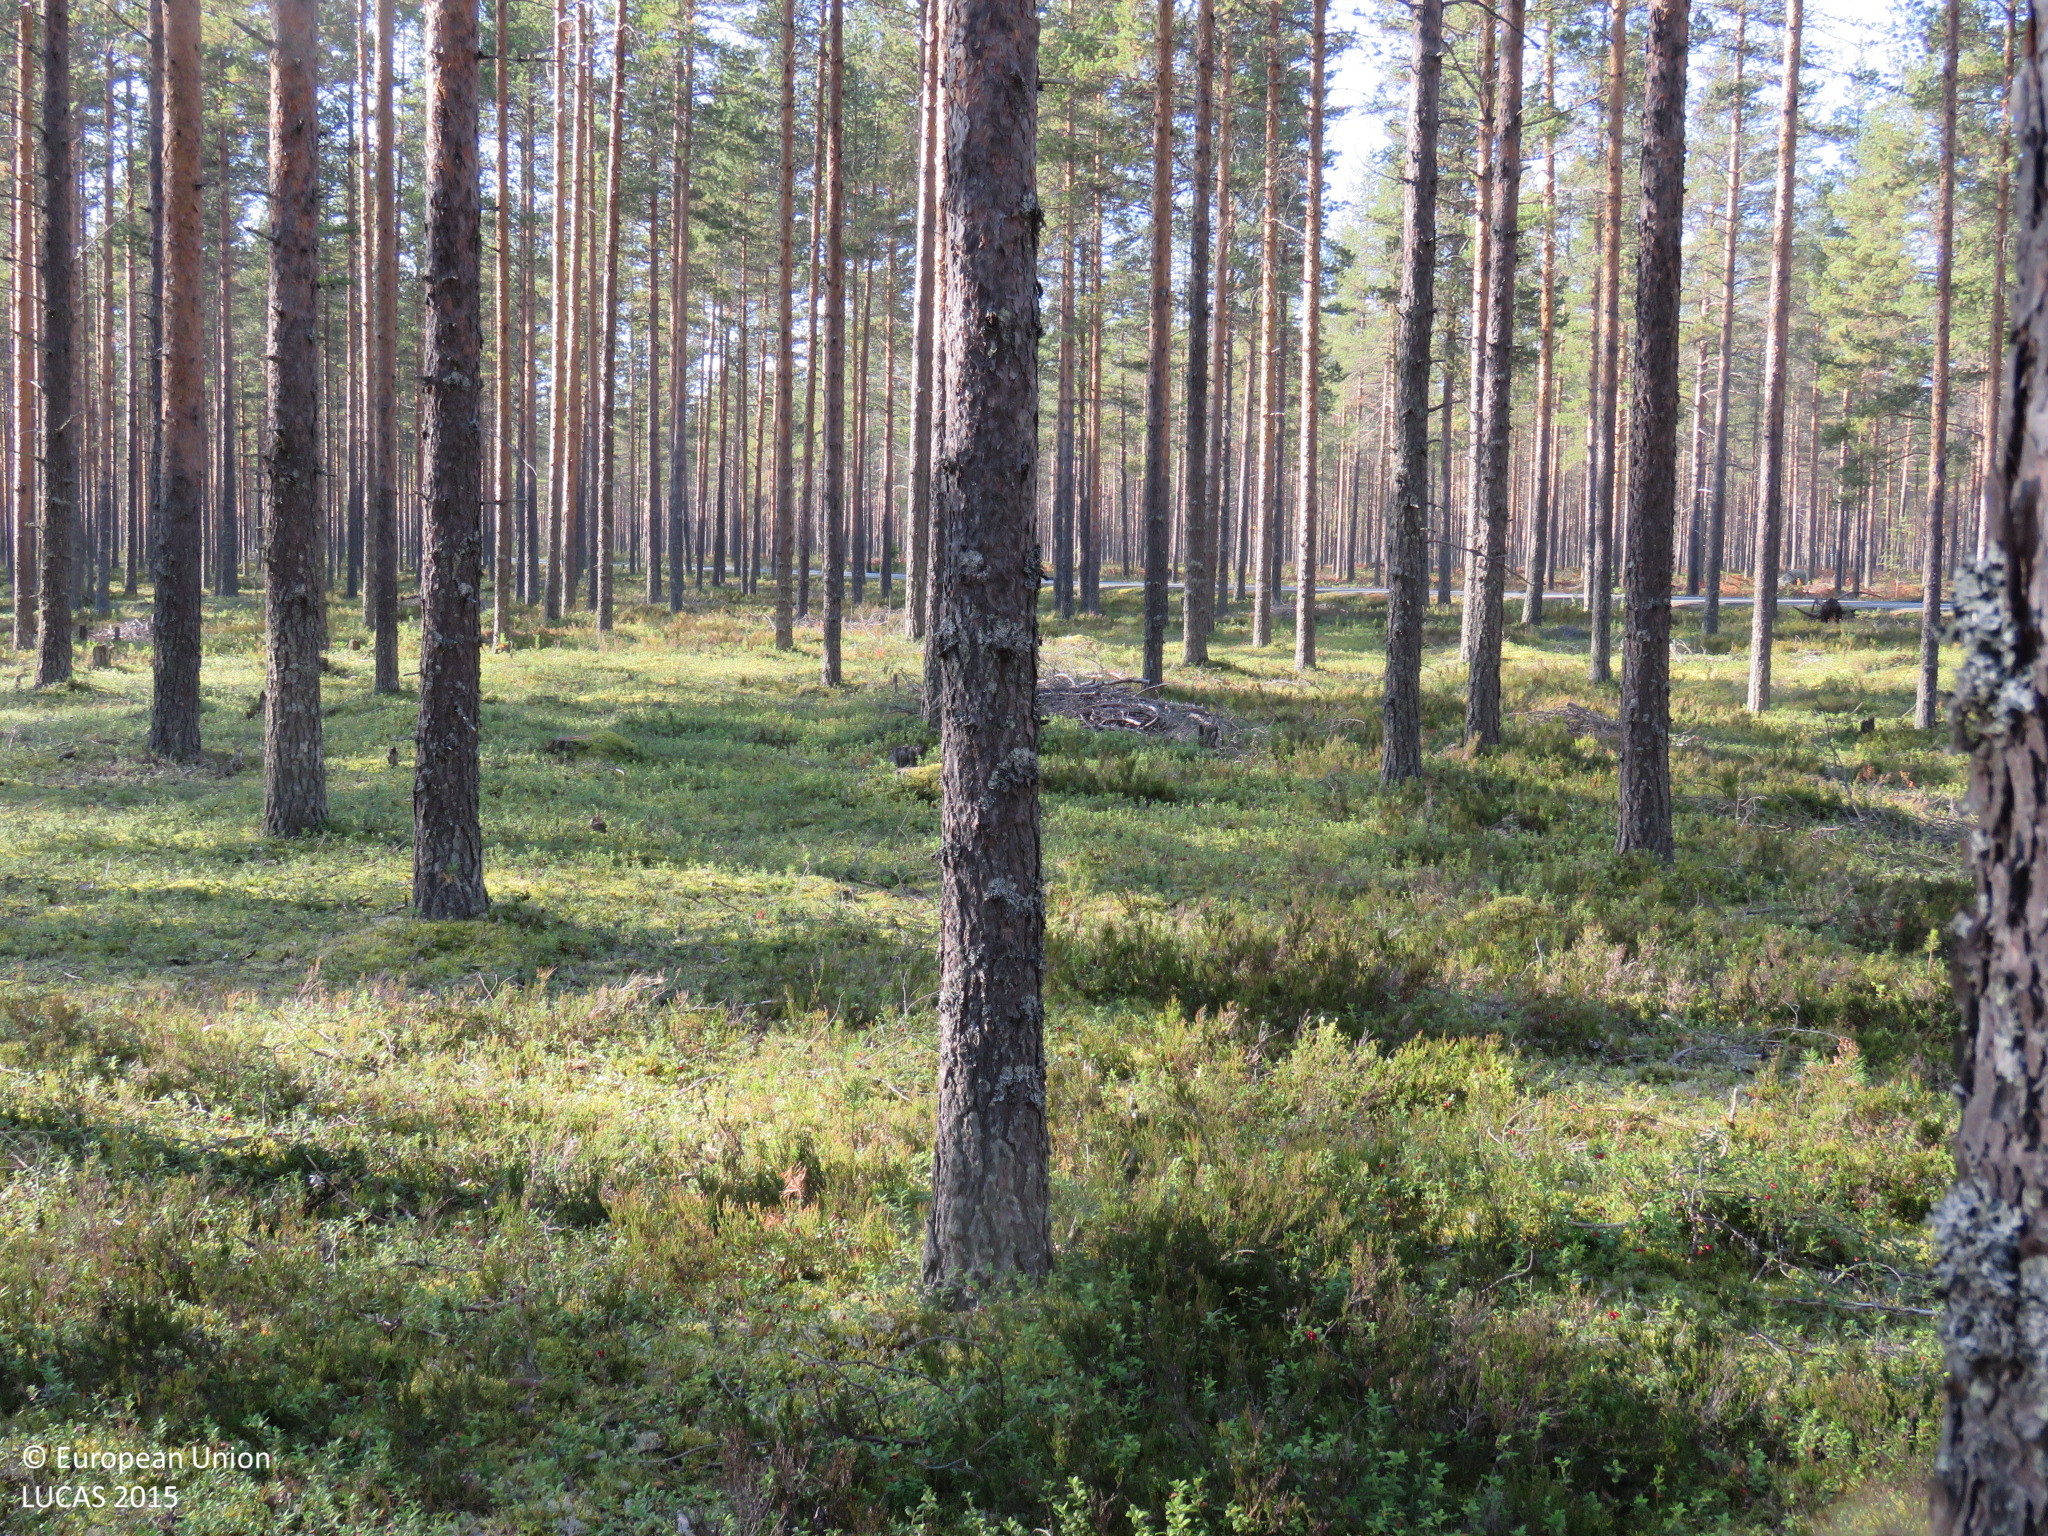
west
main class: Woodland
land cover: Pine dominated coniferous woodland
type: boreal forest
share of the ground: > 75 %
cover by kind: coniferous forest trees 75 %, shrubs 15 %, lichens and mosses 10 %
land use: Forestry
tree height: > 5 m
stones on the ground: < 10 %
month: September
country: FI
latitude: 64.9648
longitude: 26.3922
